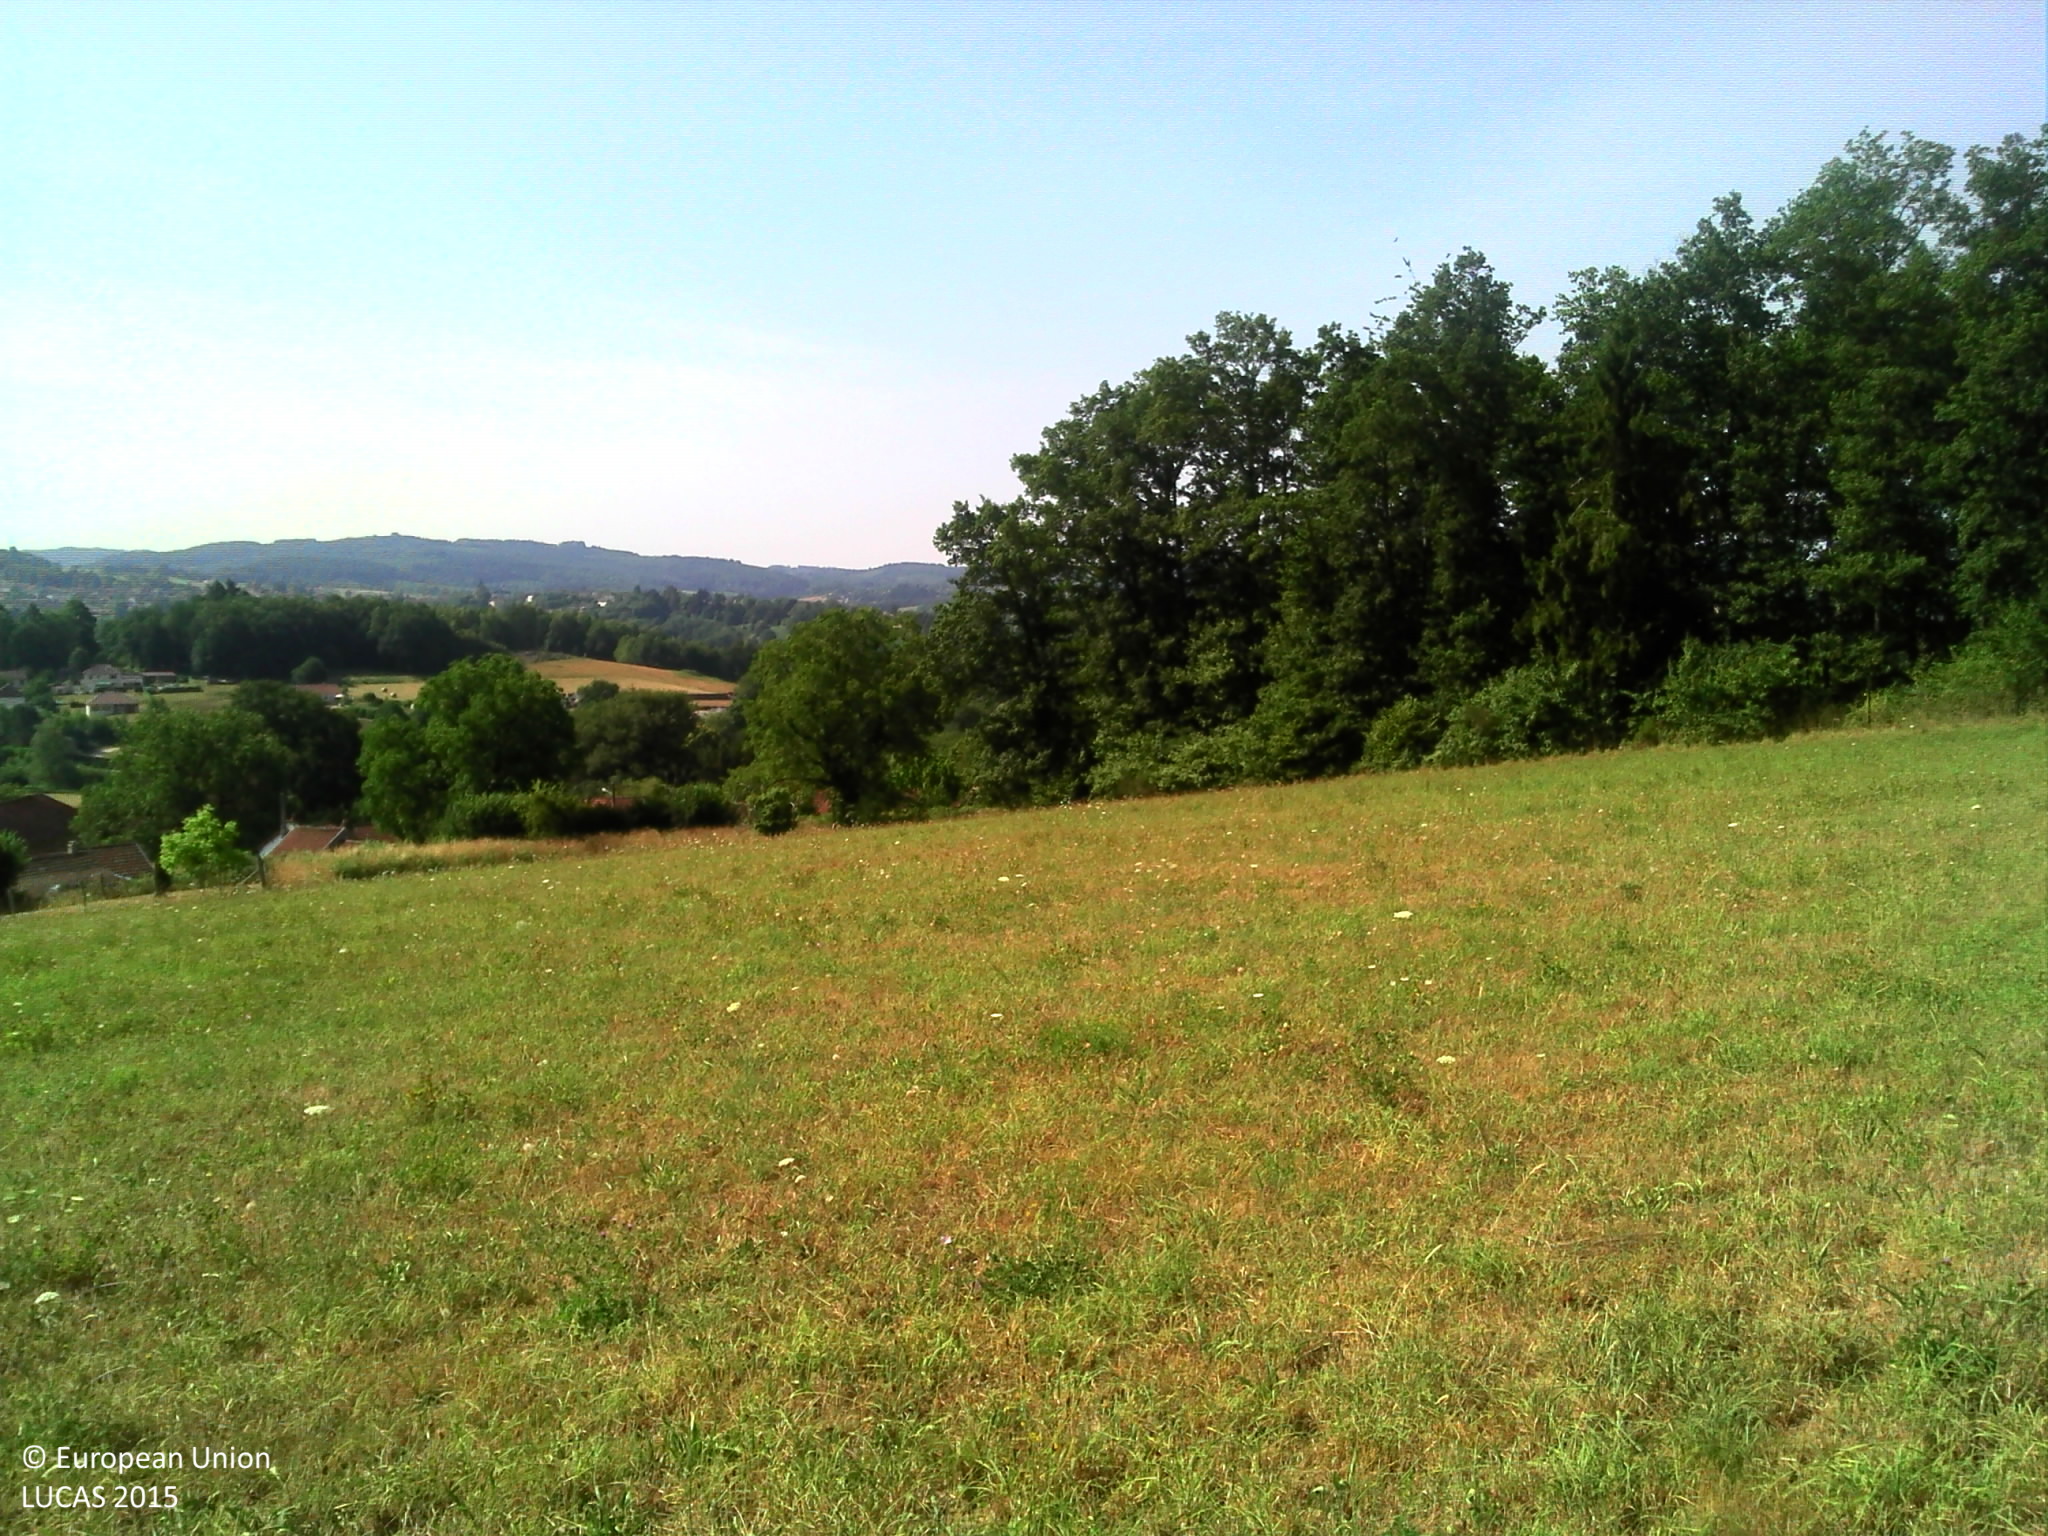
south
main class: Grassland
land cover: Grassland without tree/shrub cover
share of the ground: > 75 %
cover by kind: herbaceous plants 100 %
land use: Agriculture (excluding fallow land and kitchen gardens)
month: July
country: FR
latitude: 45.9774
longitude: 1.7454
